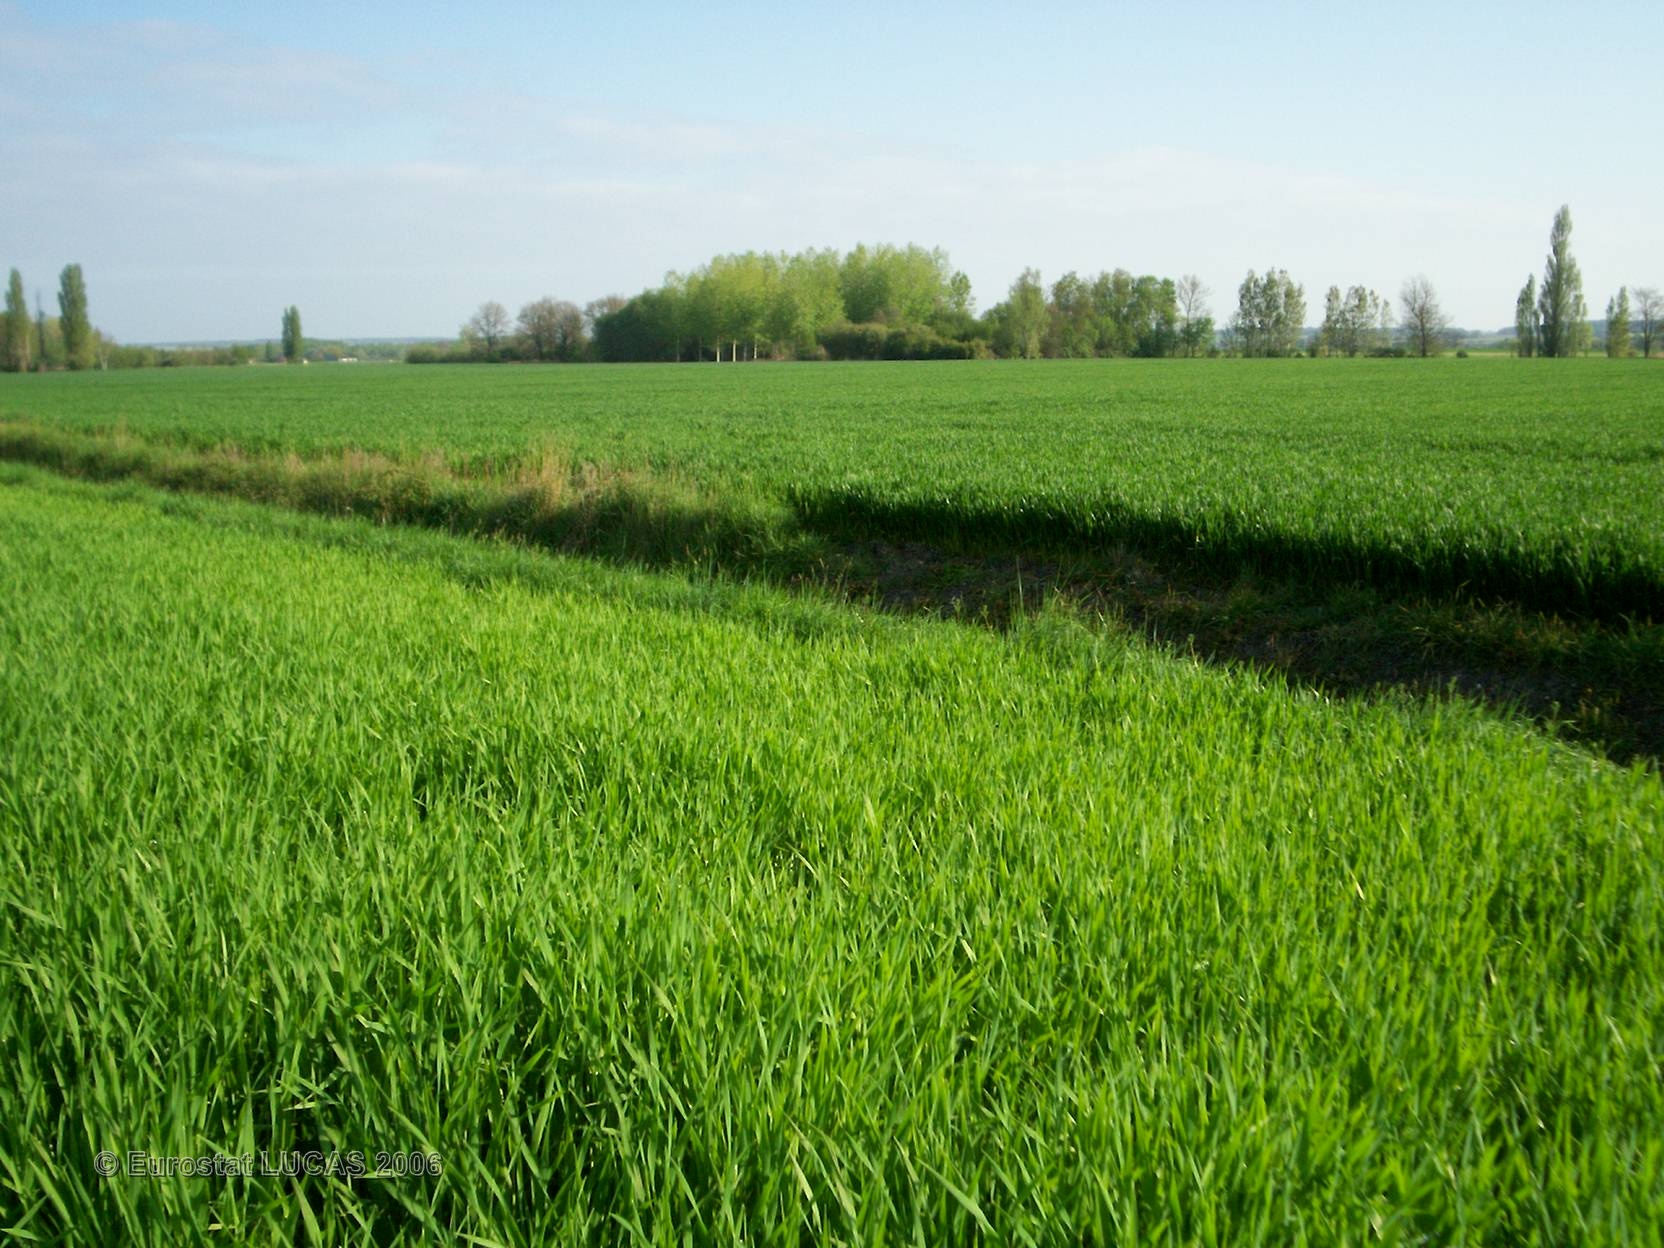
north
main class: Cropland
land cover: Barley
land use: Agriculture (excluding fallow land and kitchen gardens)
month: April
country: FR
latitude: 47.1016
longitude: 0.4534
